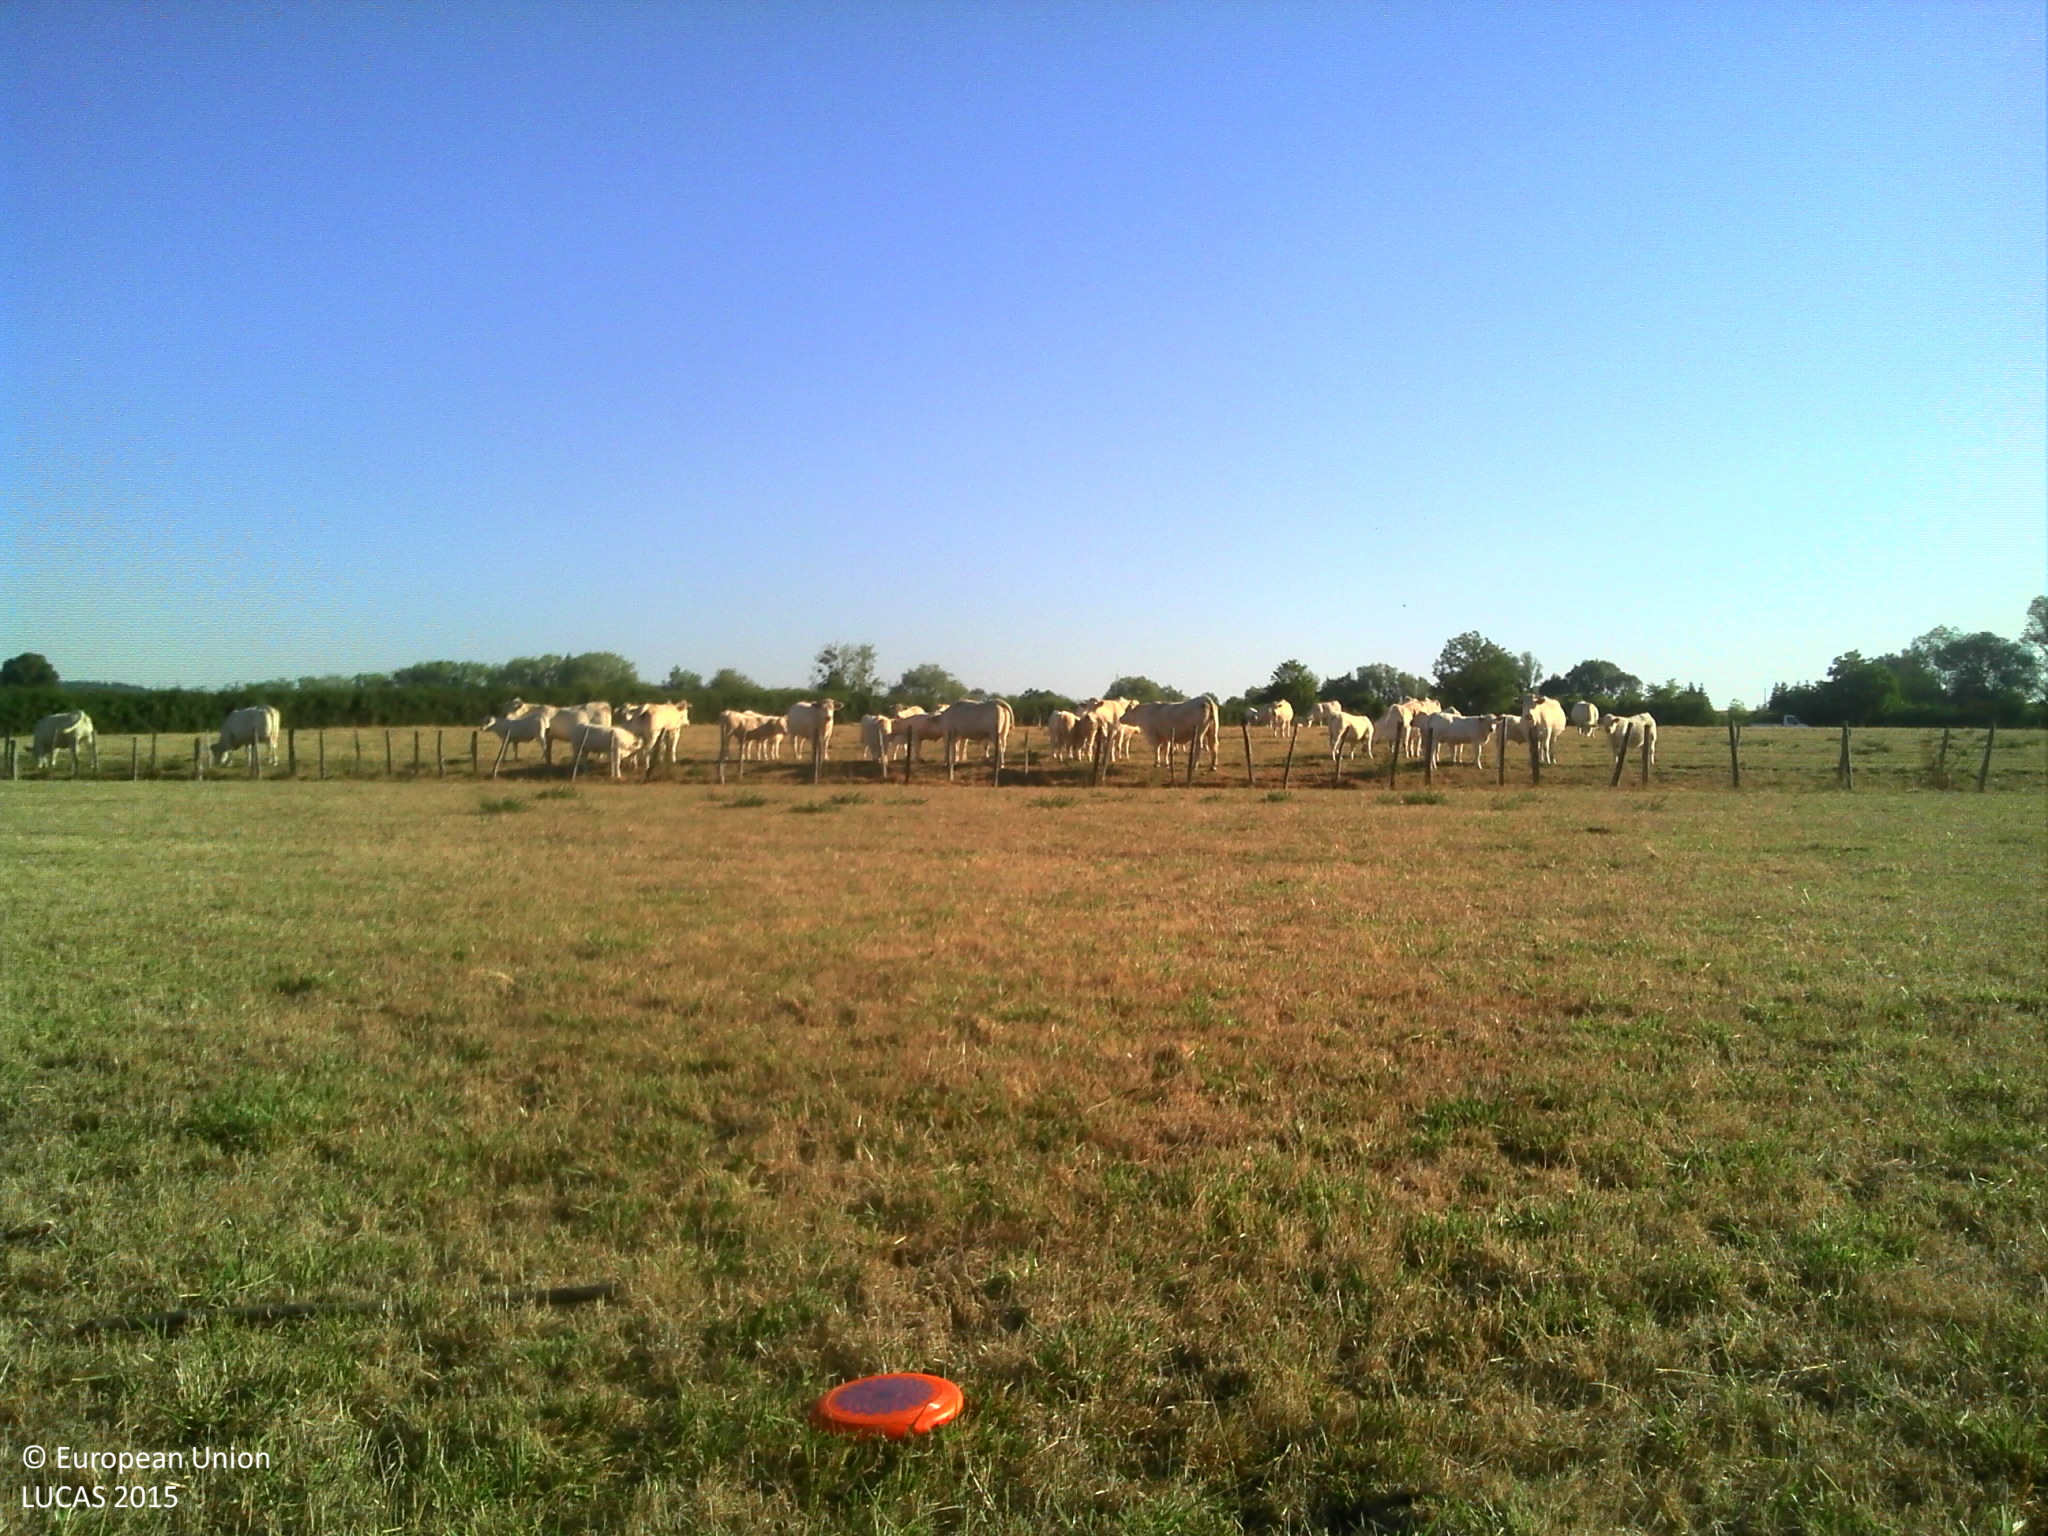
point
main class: Grassland
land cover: Grassland without tree/shrub cover
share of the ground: > 75 %
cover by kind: herbaceous plants 100 %
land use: Agriculture (excluding fallow land and kitchen gardens)
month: August
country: FR
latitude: 46.8176
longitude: 4.7453
